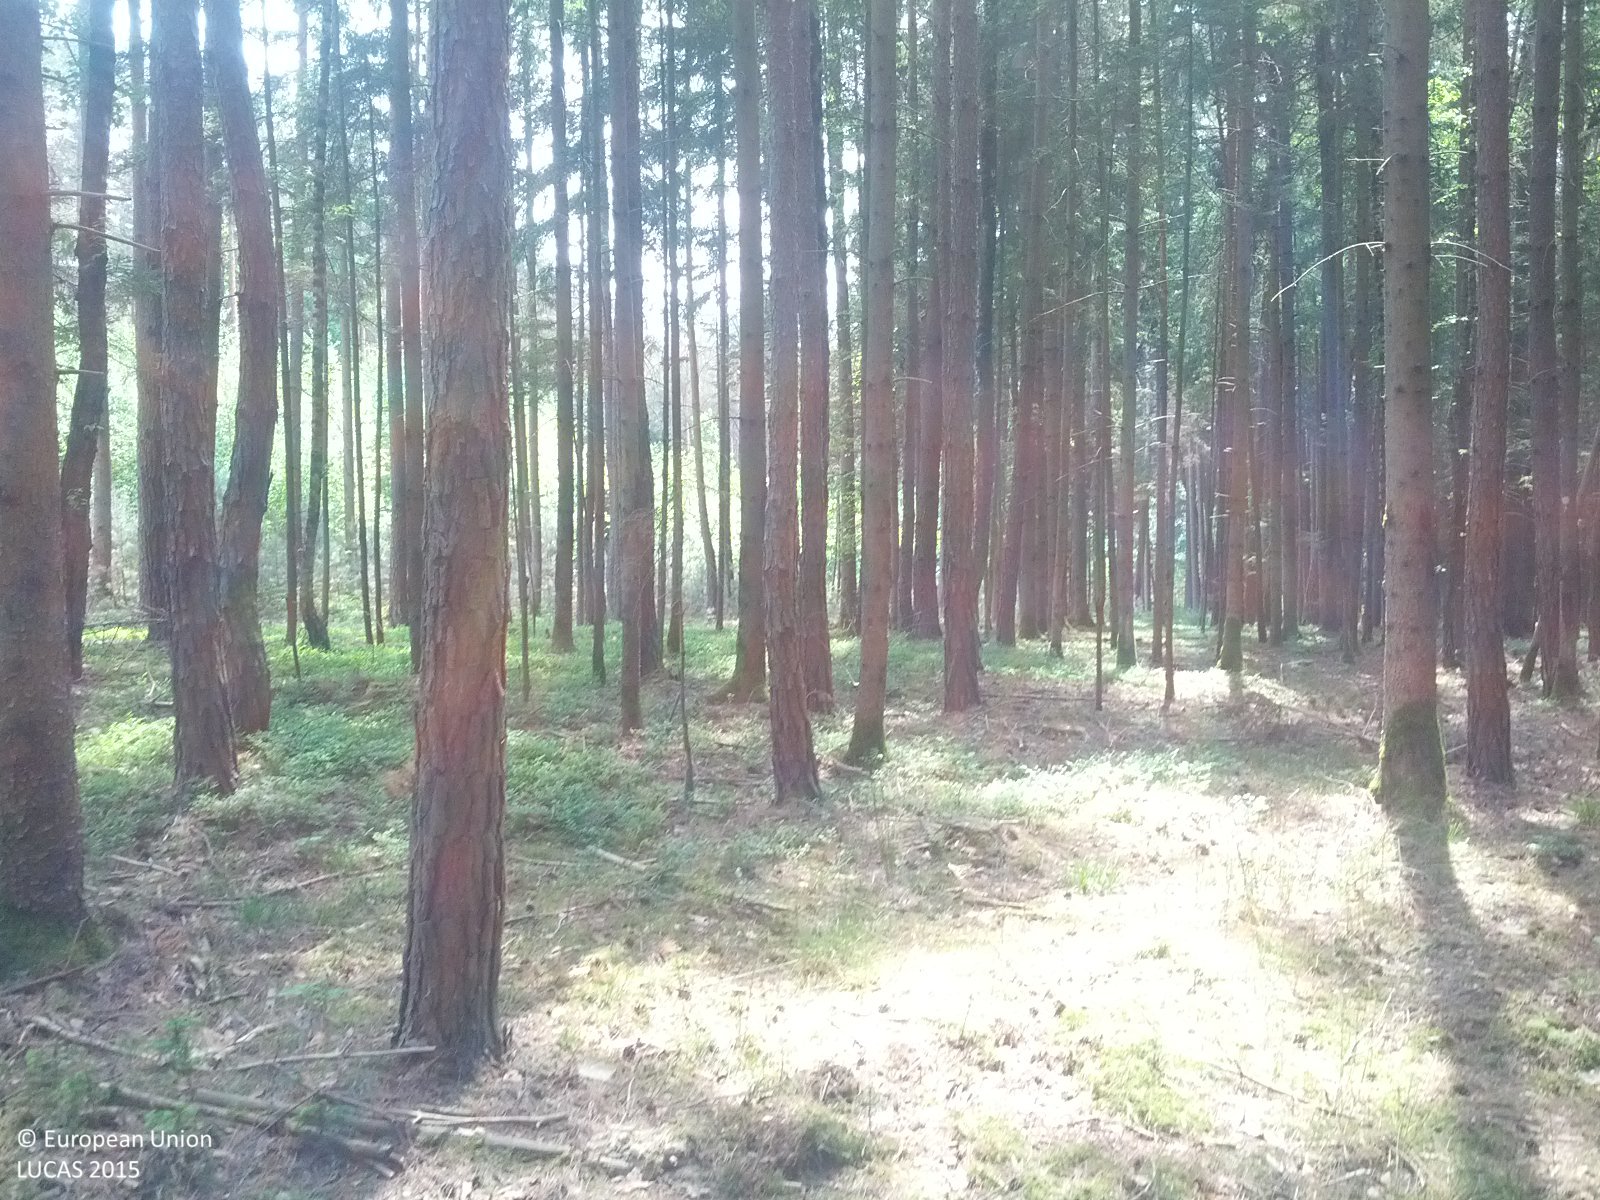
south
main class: Woodland
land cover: Pine dominated coniferous woodland
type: boreal forest
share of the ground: > 75 %
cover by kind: coniferous forest trees 80 %, lichens and mosses 10 %, shrubs 5 %, herbaceous plants 5 %
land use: Forestry
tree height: > 5 m
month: May
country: AT
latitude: 47.3311
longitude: 16.1290
